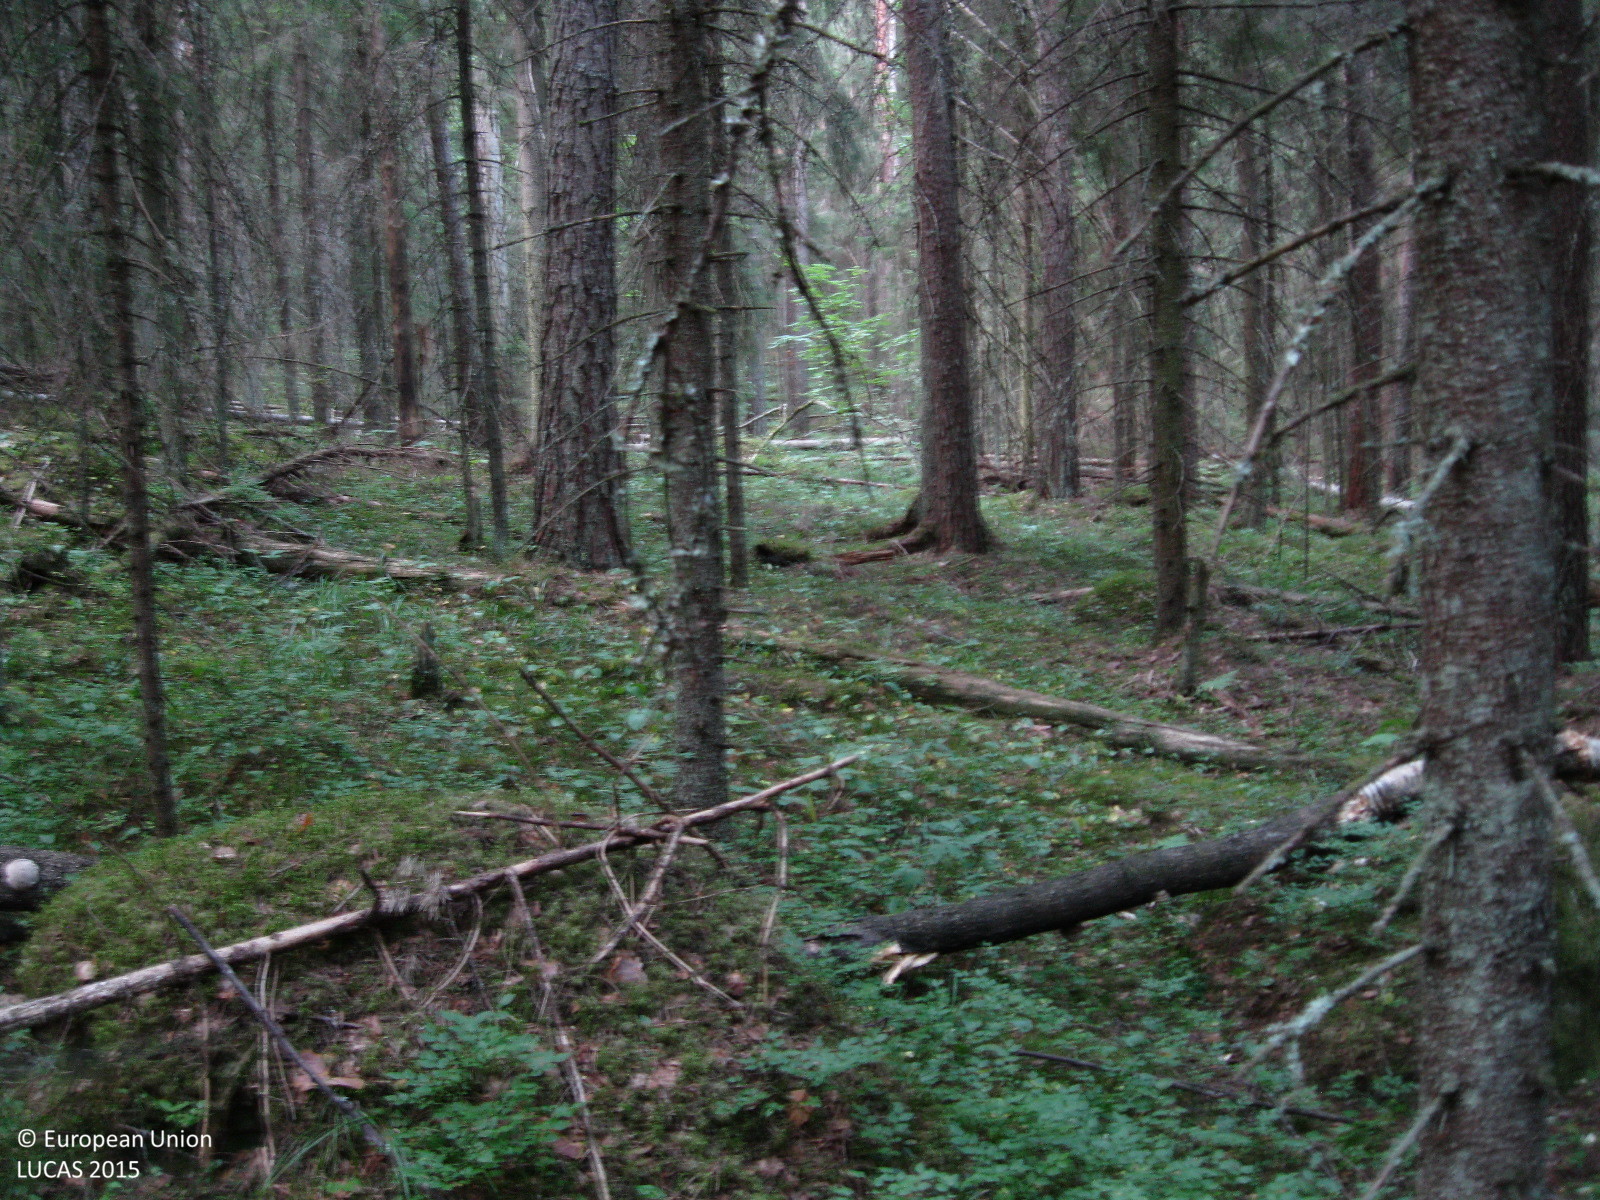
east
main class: Woodland
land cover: Other coniferous woodland
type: boreal forest
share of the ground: > 75 %
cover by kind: coniferous forest trees 85 %, herbaceous plants 10 %, broadleaved forest trees 5 %
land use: Forestry
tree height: > 5 m
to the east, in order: Other coniferous woodland; Electric lines; Other coniferous woodland; Grass margins; Paved roads, cycling and walking lanes; Grass margins; Grassland without tree/shrub cover; Spruce dominated mixed woodland; Spruce dominated coniferous woodland; Ponds and wetlands; Spruce dominated mixed woodland
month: August
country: FI
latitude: 61.3057
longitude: 25.1440
